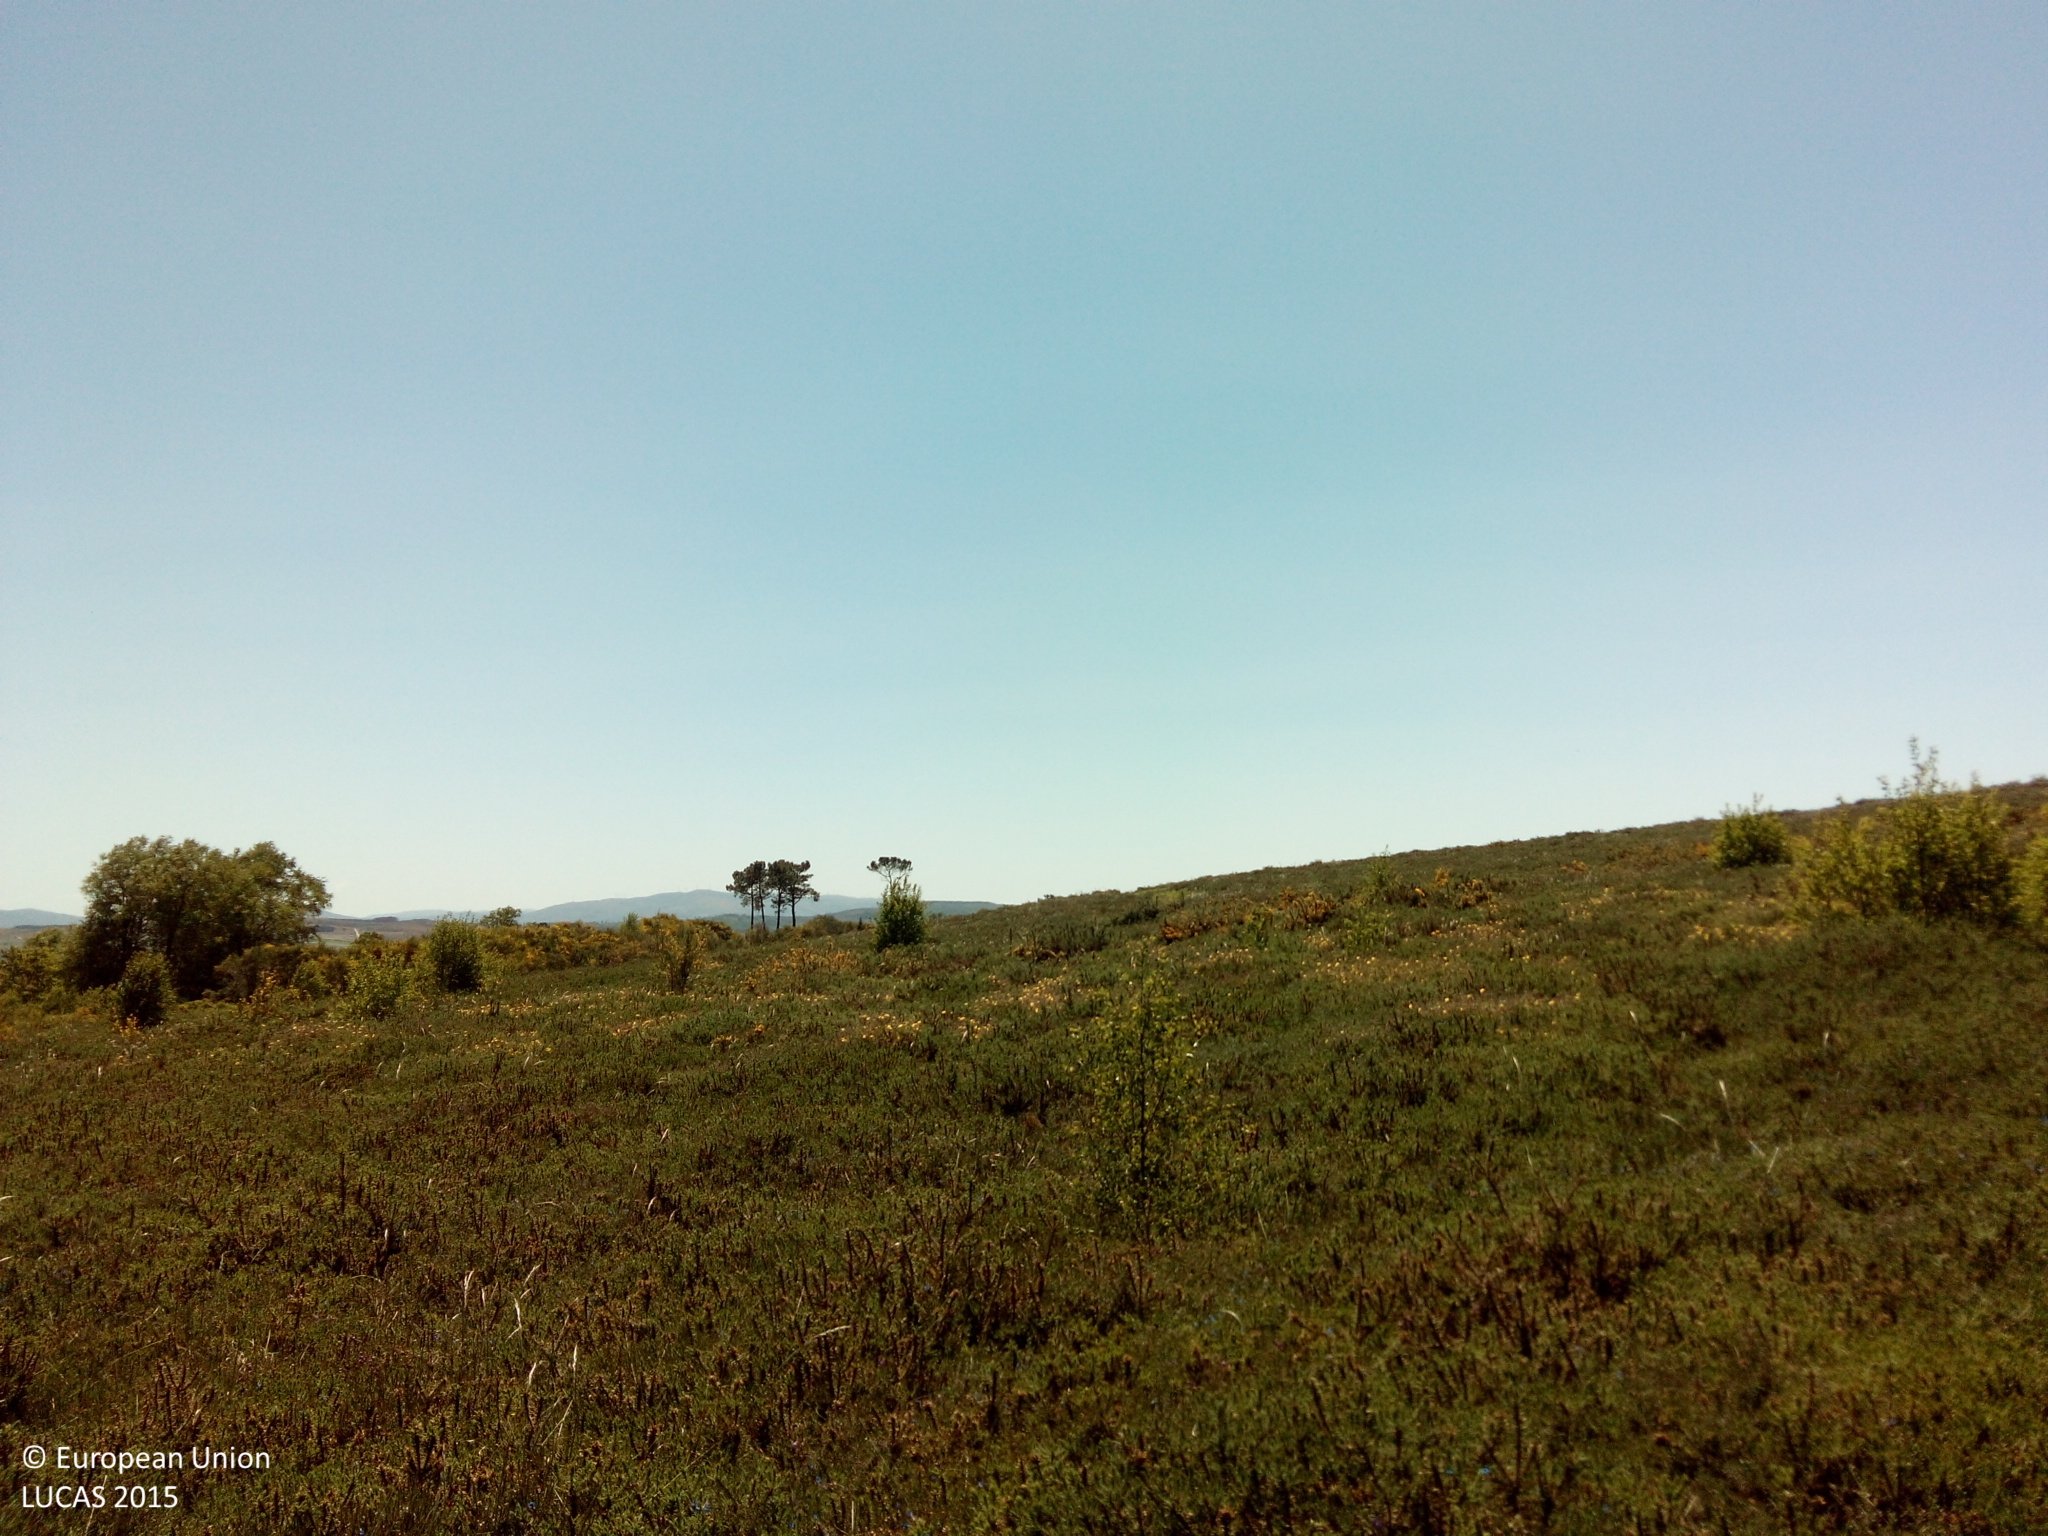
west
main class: Shrubland
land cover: Shrubland without tree cover
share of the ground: > 75 %
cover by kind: shrubs 100 %
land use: Semi-natural and natural areas not in use
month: May
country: ES
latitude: 42.6757
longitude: -8.3639
